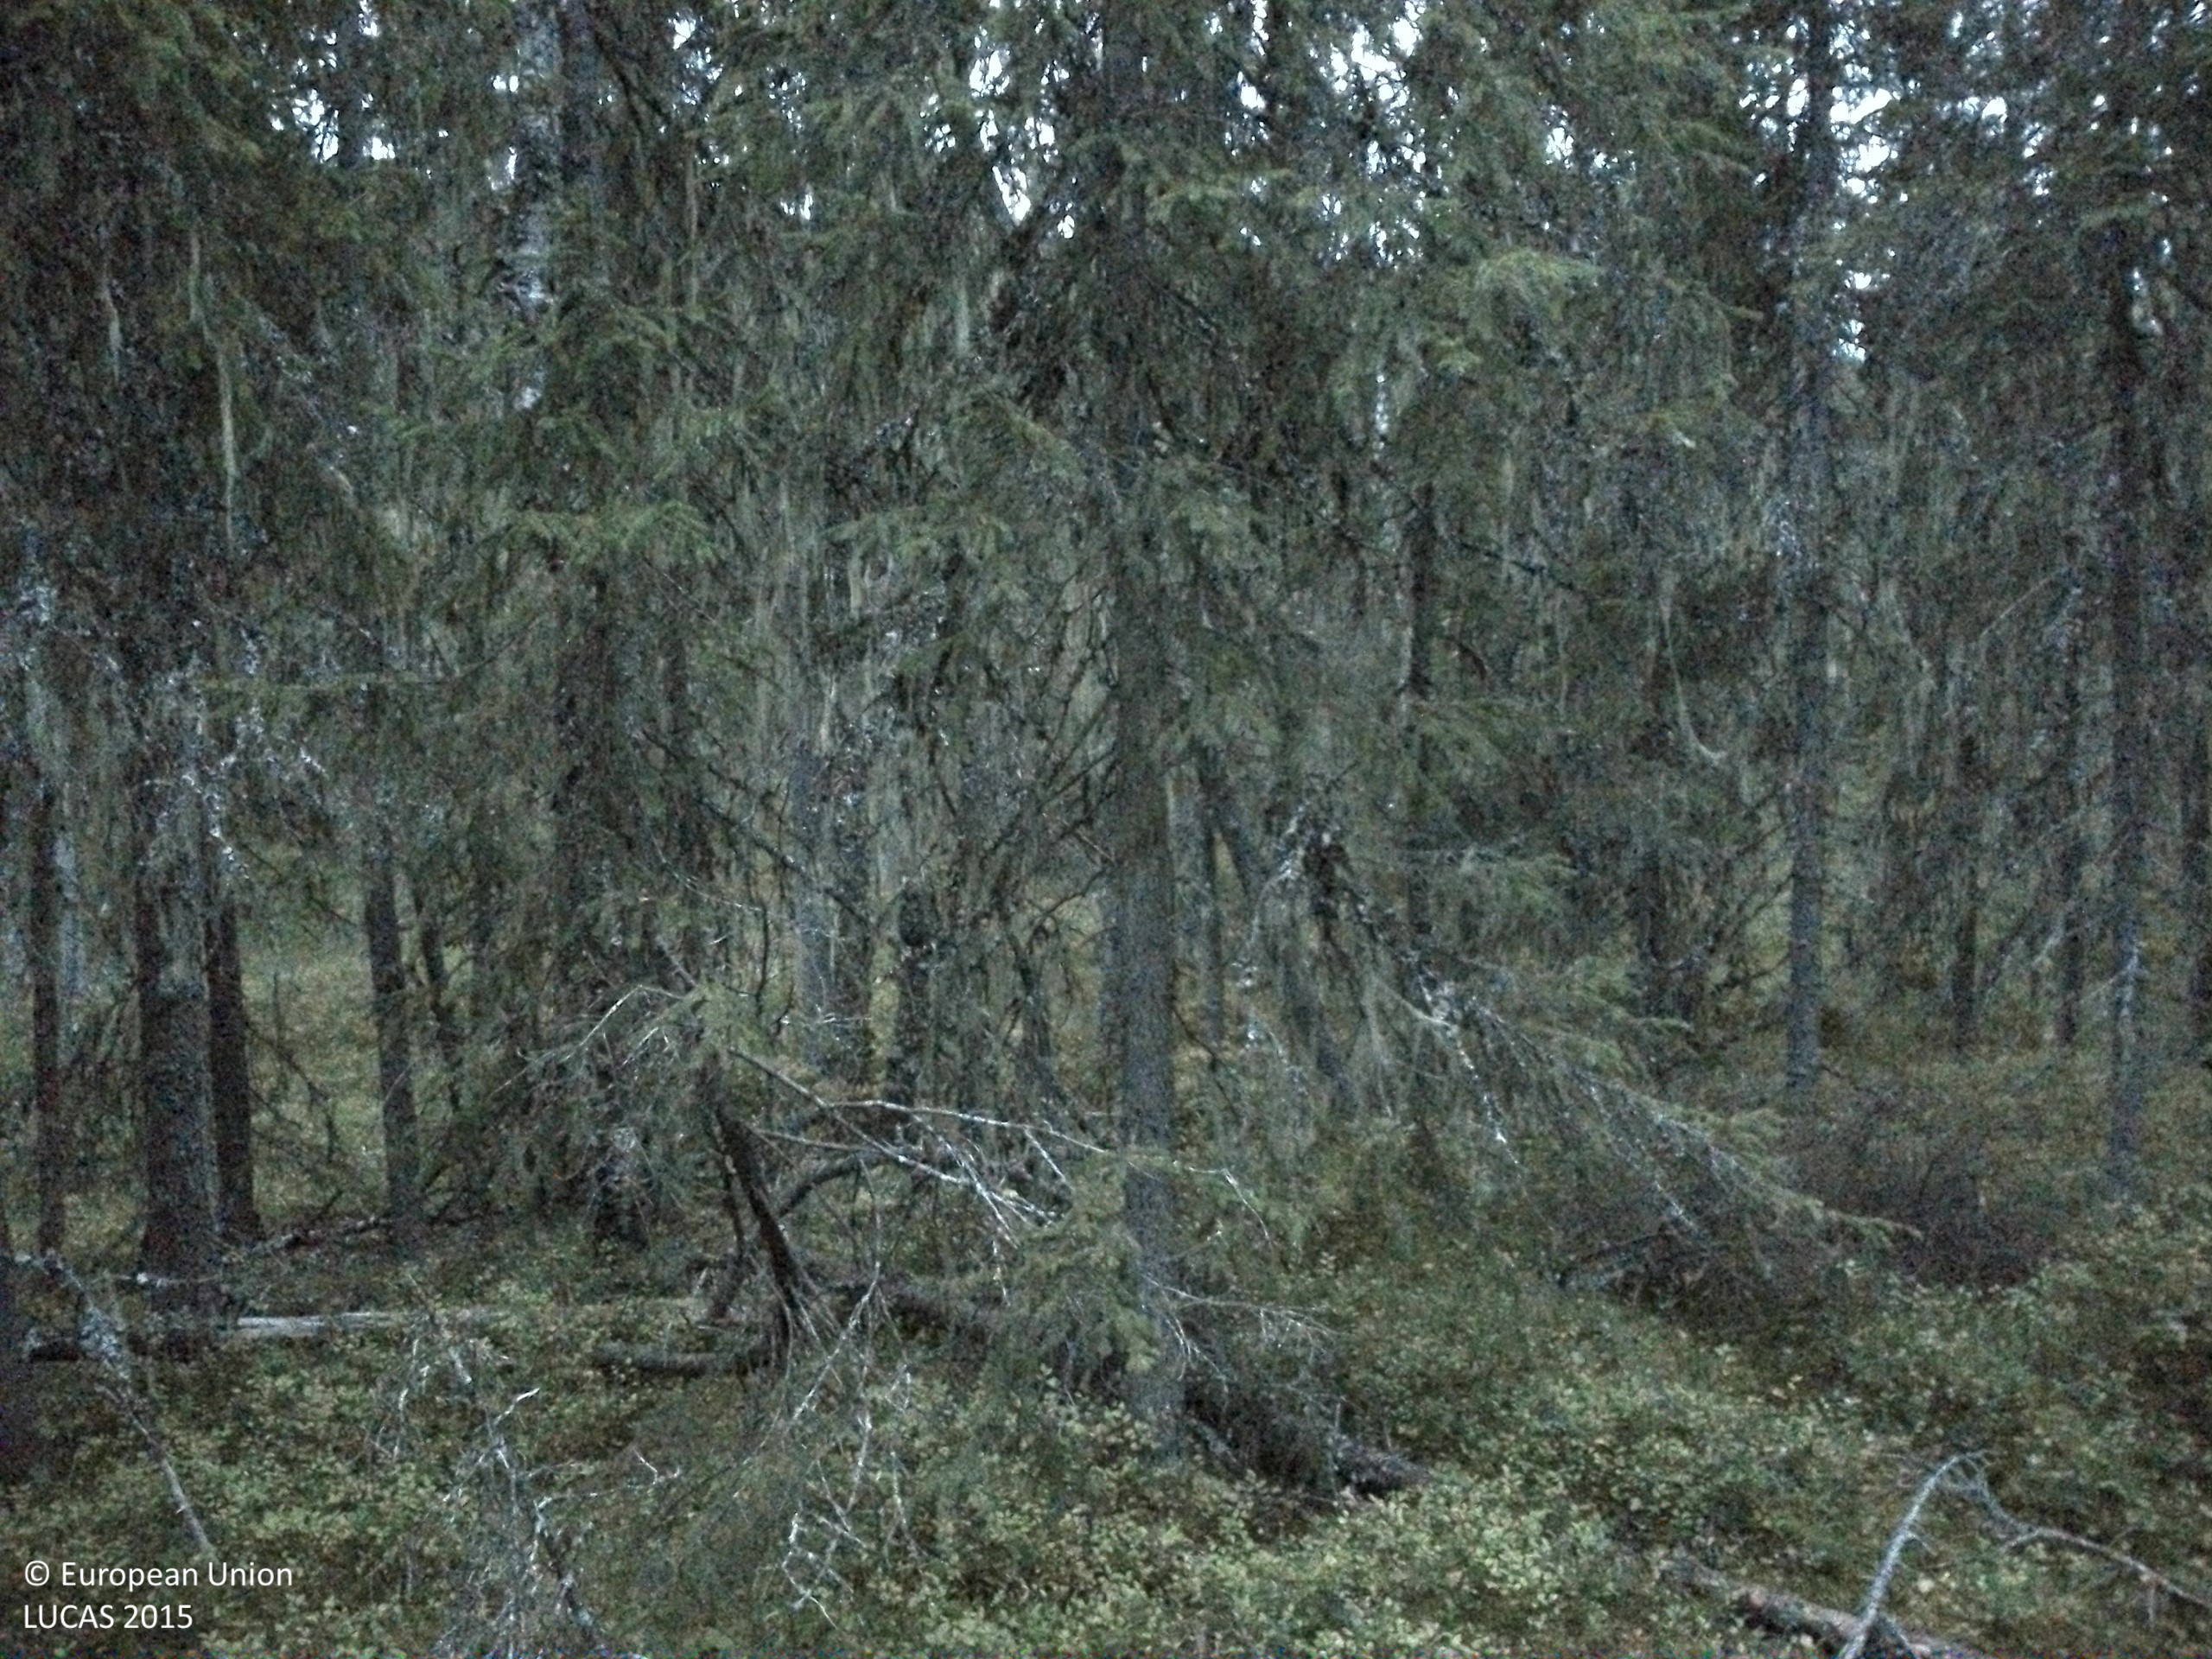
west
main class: Woodland
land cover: Spruce dominated coniferous woodland
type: boreal forest
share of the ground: 50 - 75 %
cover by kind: coniferous forest trees 65 %, shrubs 30 %, broadleaved forest trees 5 %
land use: Forestry
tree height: > 5 m
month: October
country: SE
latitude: 61.3943
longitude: 14.3482
